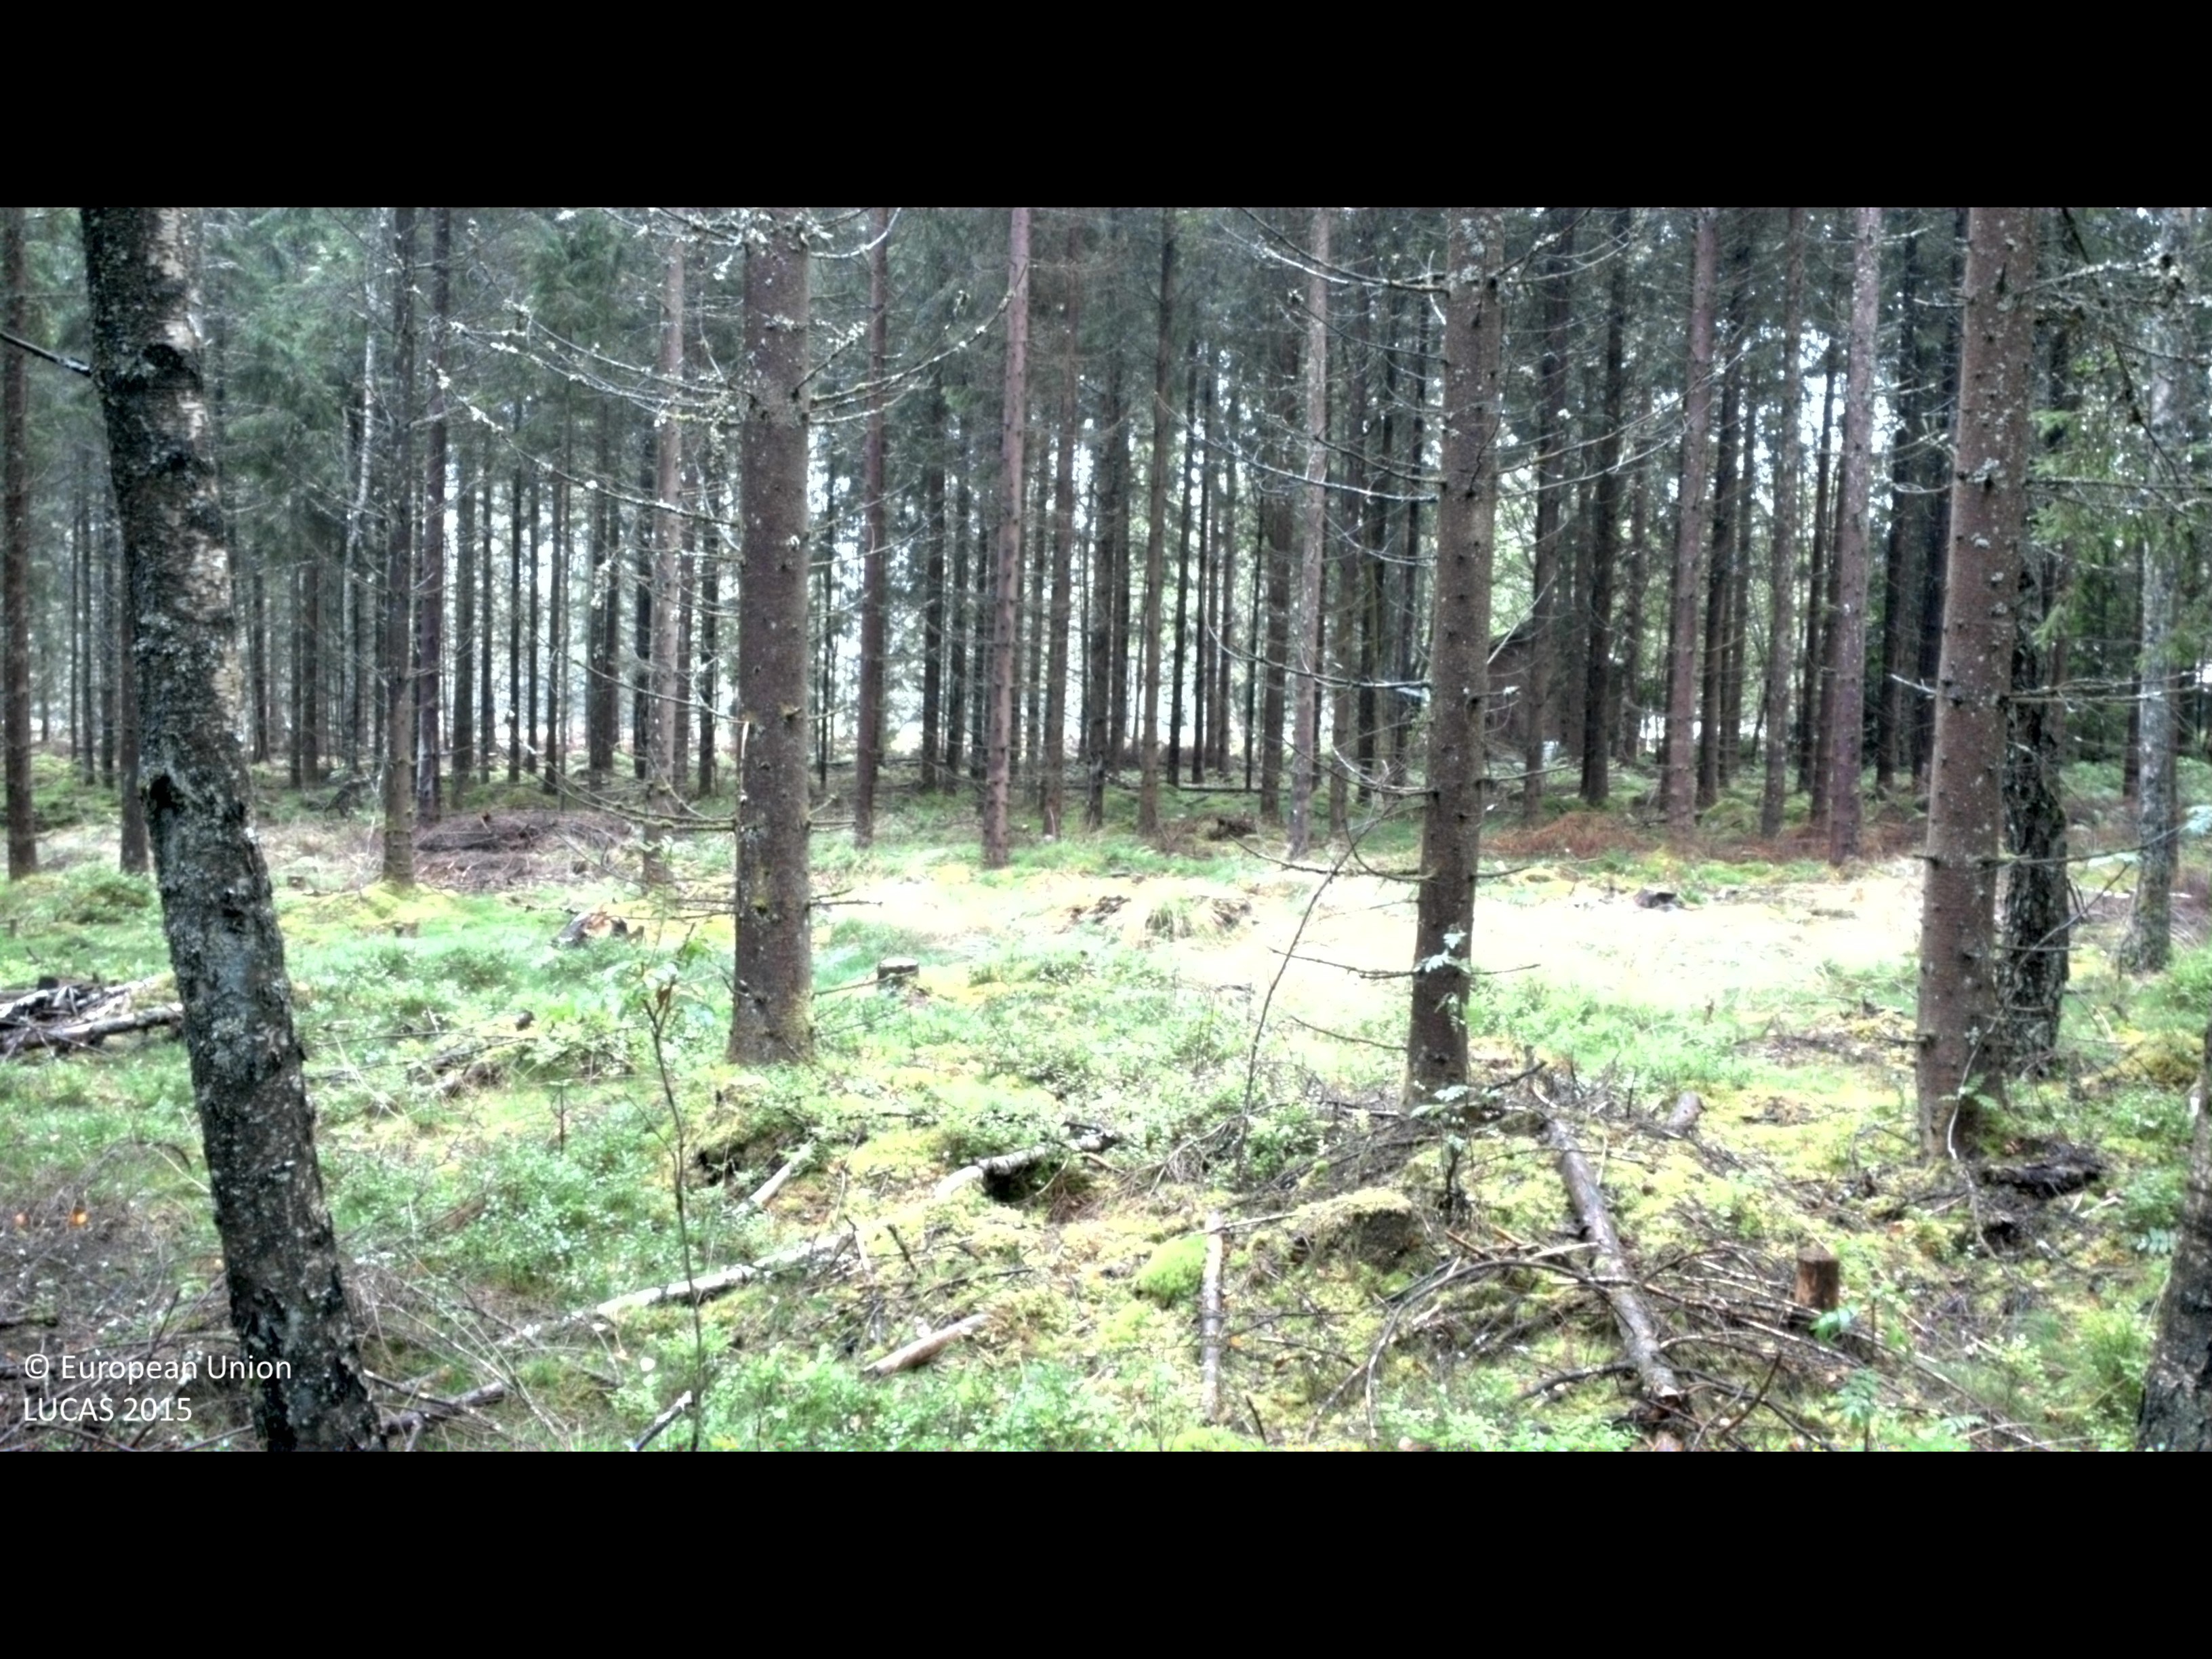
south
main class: Woodland
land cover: Spruce dominated coniferous woodland
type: boreal forest
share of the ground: 50 - 75 %
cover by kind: coniferous forest trees 55 %, shrubs 35 %, broadleaved forest trees 5 %, herbaceous plants 5 %
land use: Forestry
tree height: > 5 m
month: September
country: SE
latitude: 57.3905
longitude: 13.8389
